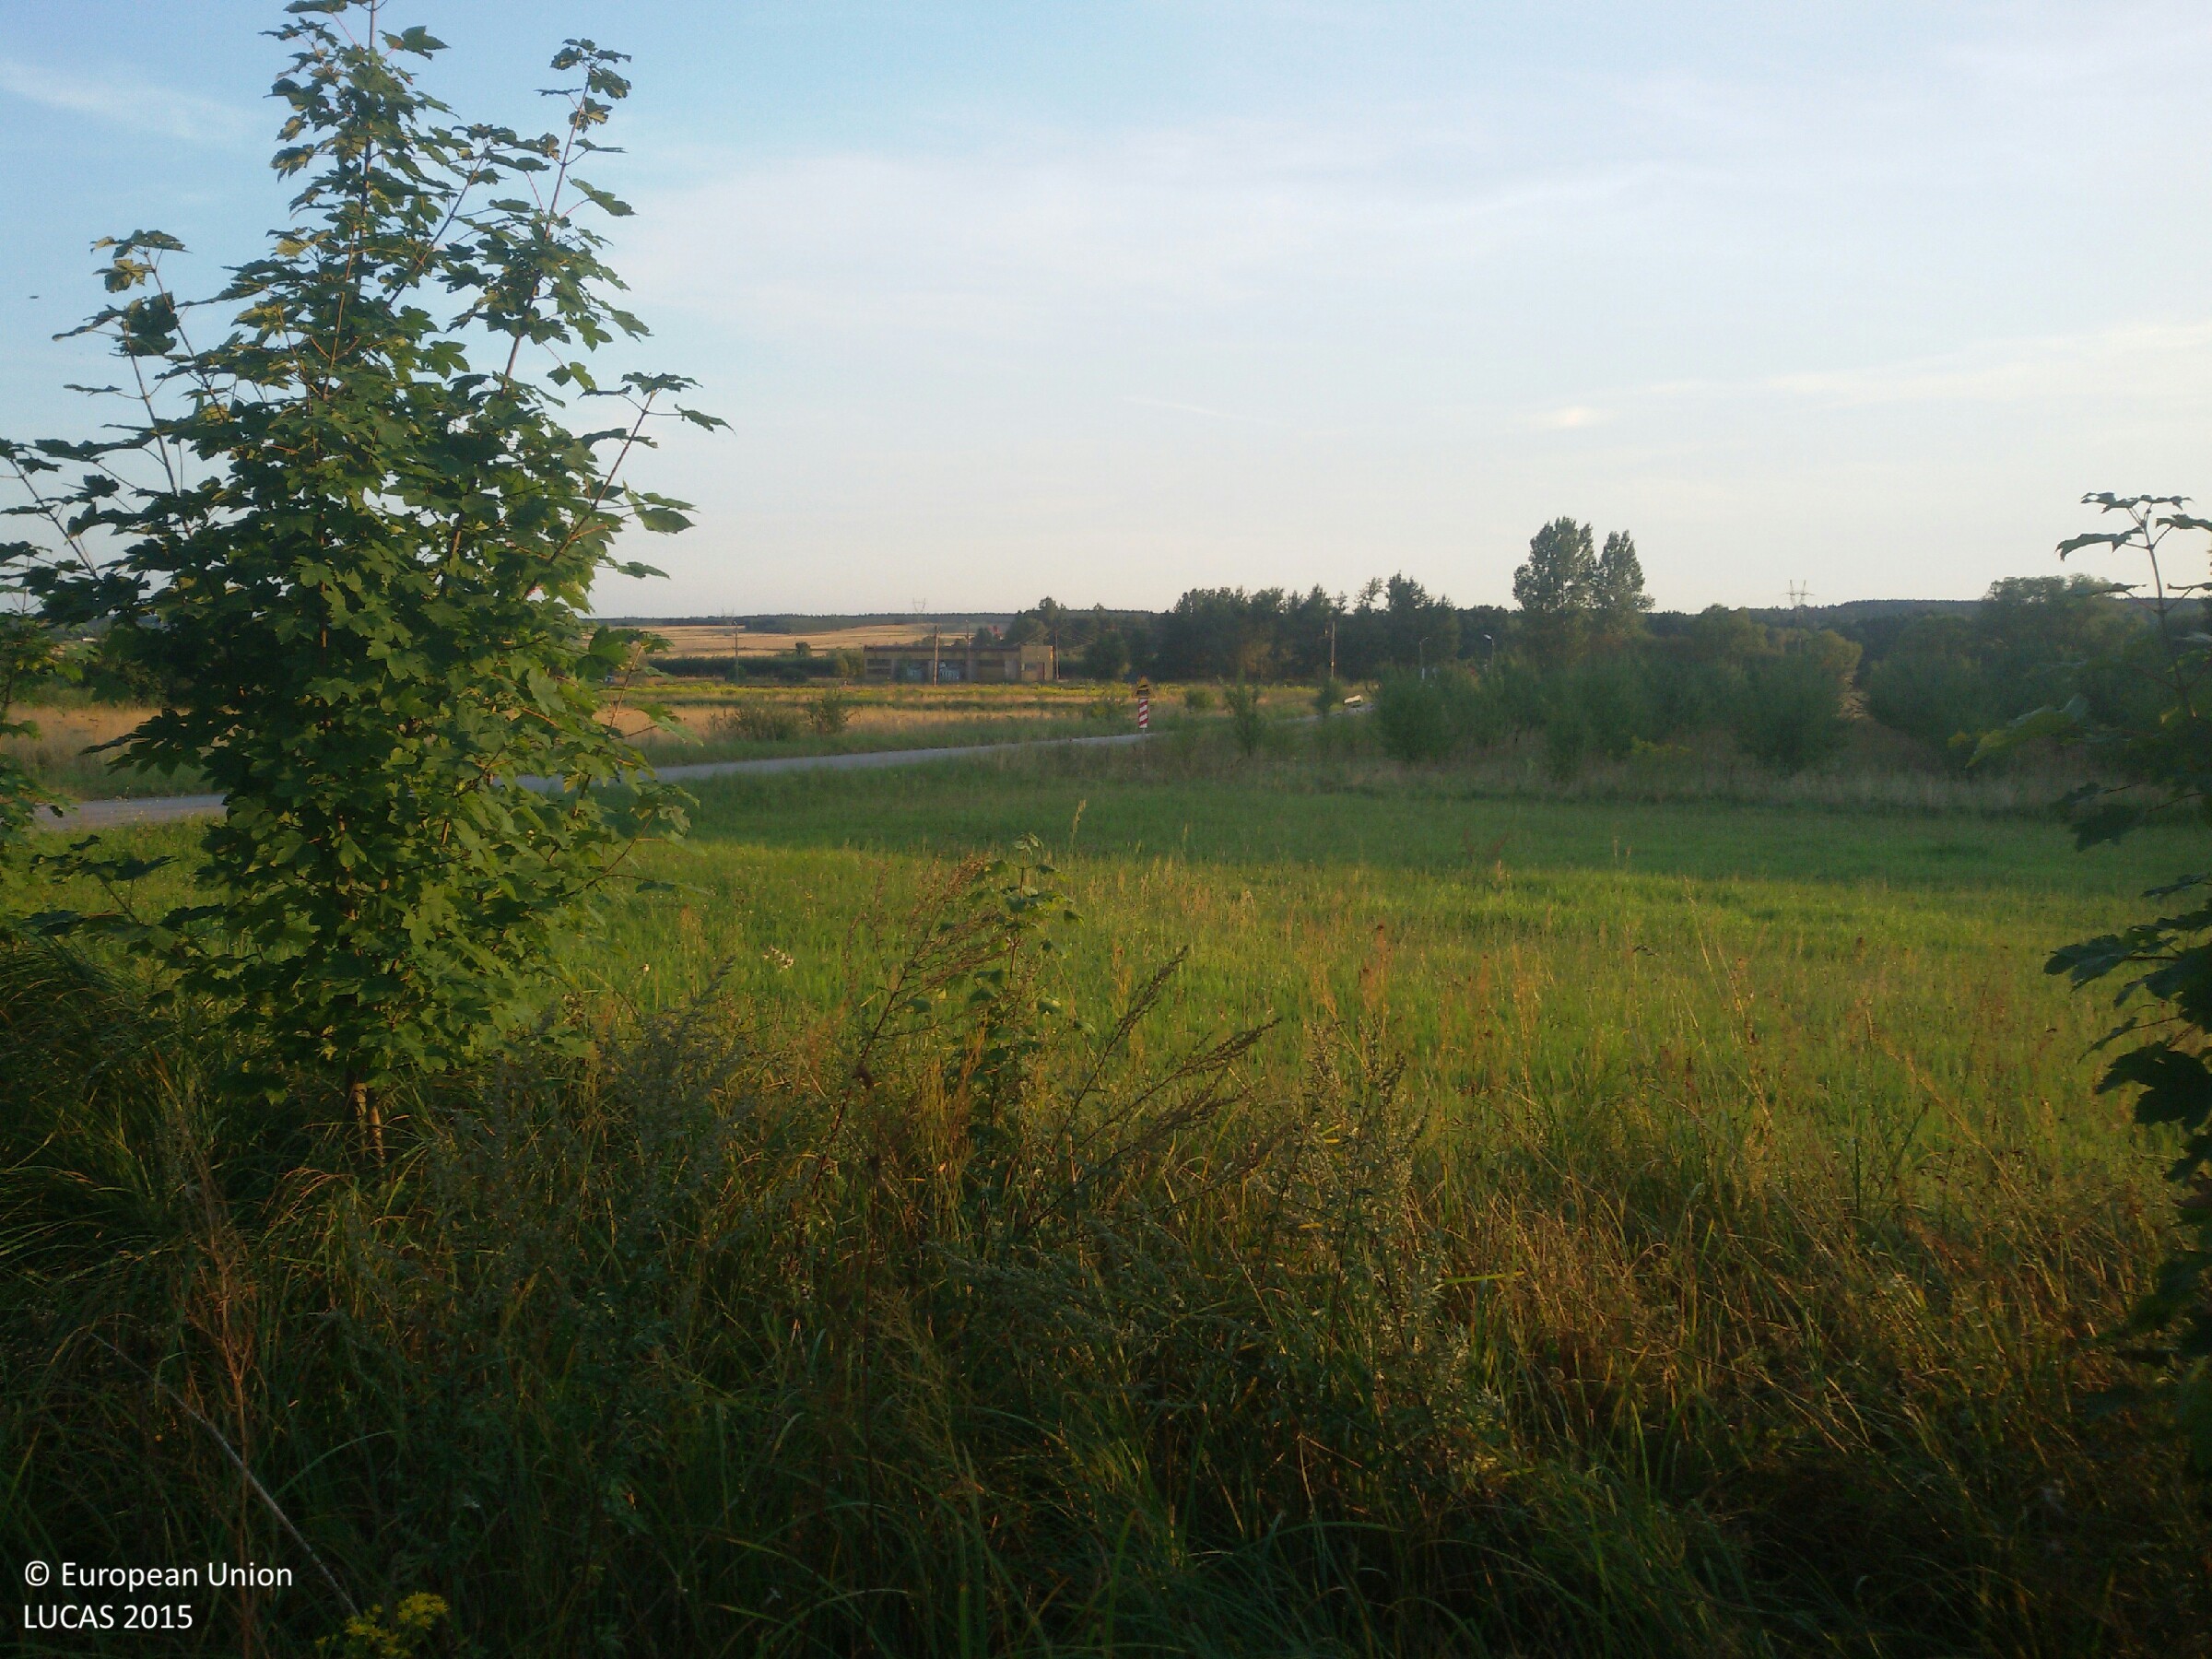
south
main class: Woodland
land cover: Broadleaved woodland
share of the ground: 25 - 50 %
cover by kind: herbaceous plants 55 %, broadleaved forest trees 40 %, coniferous forest trees 5 %
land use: Forestry
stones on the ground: < 10 %
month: August
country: PL
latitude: 50.5904
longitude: 20.8482
